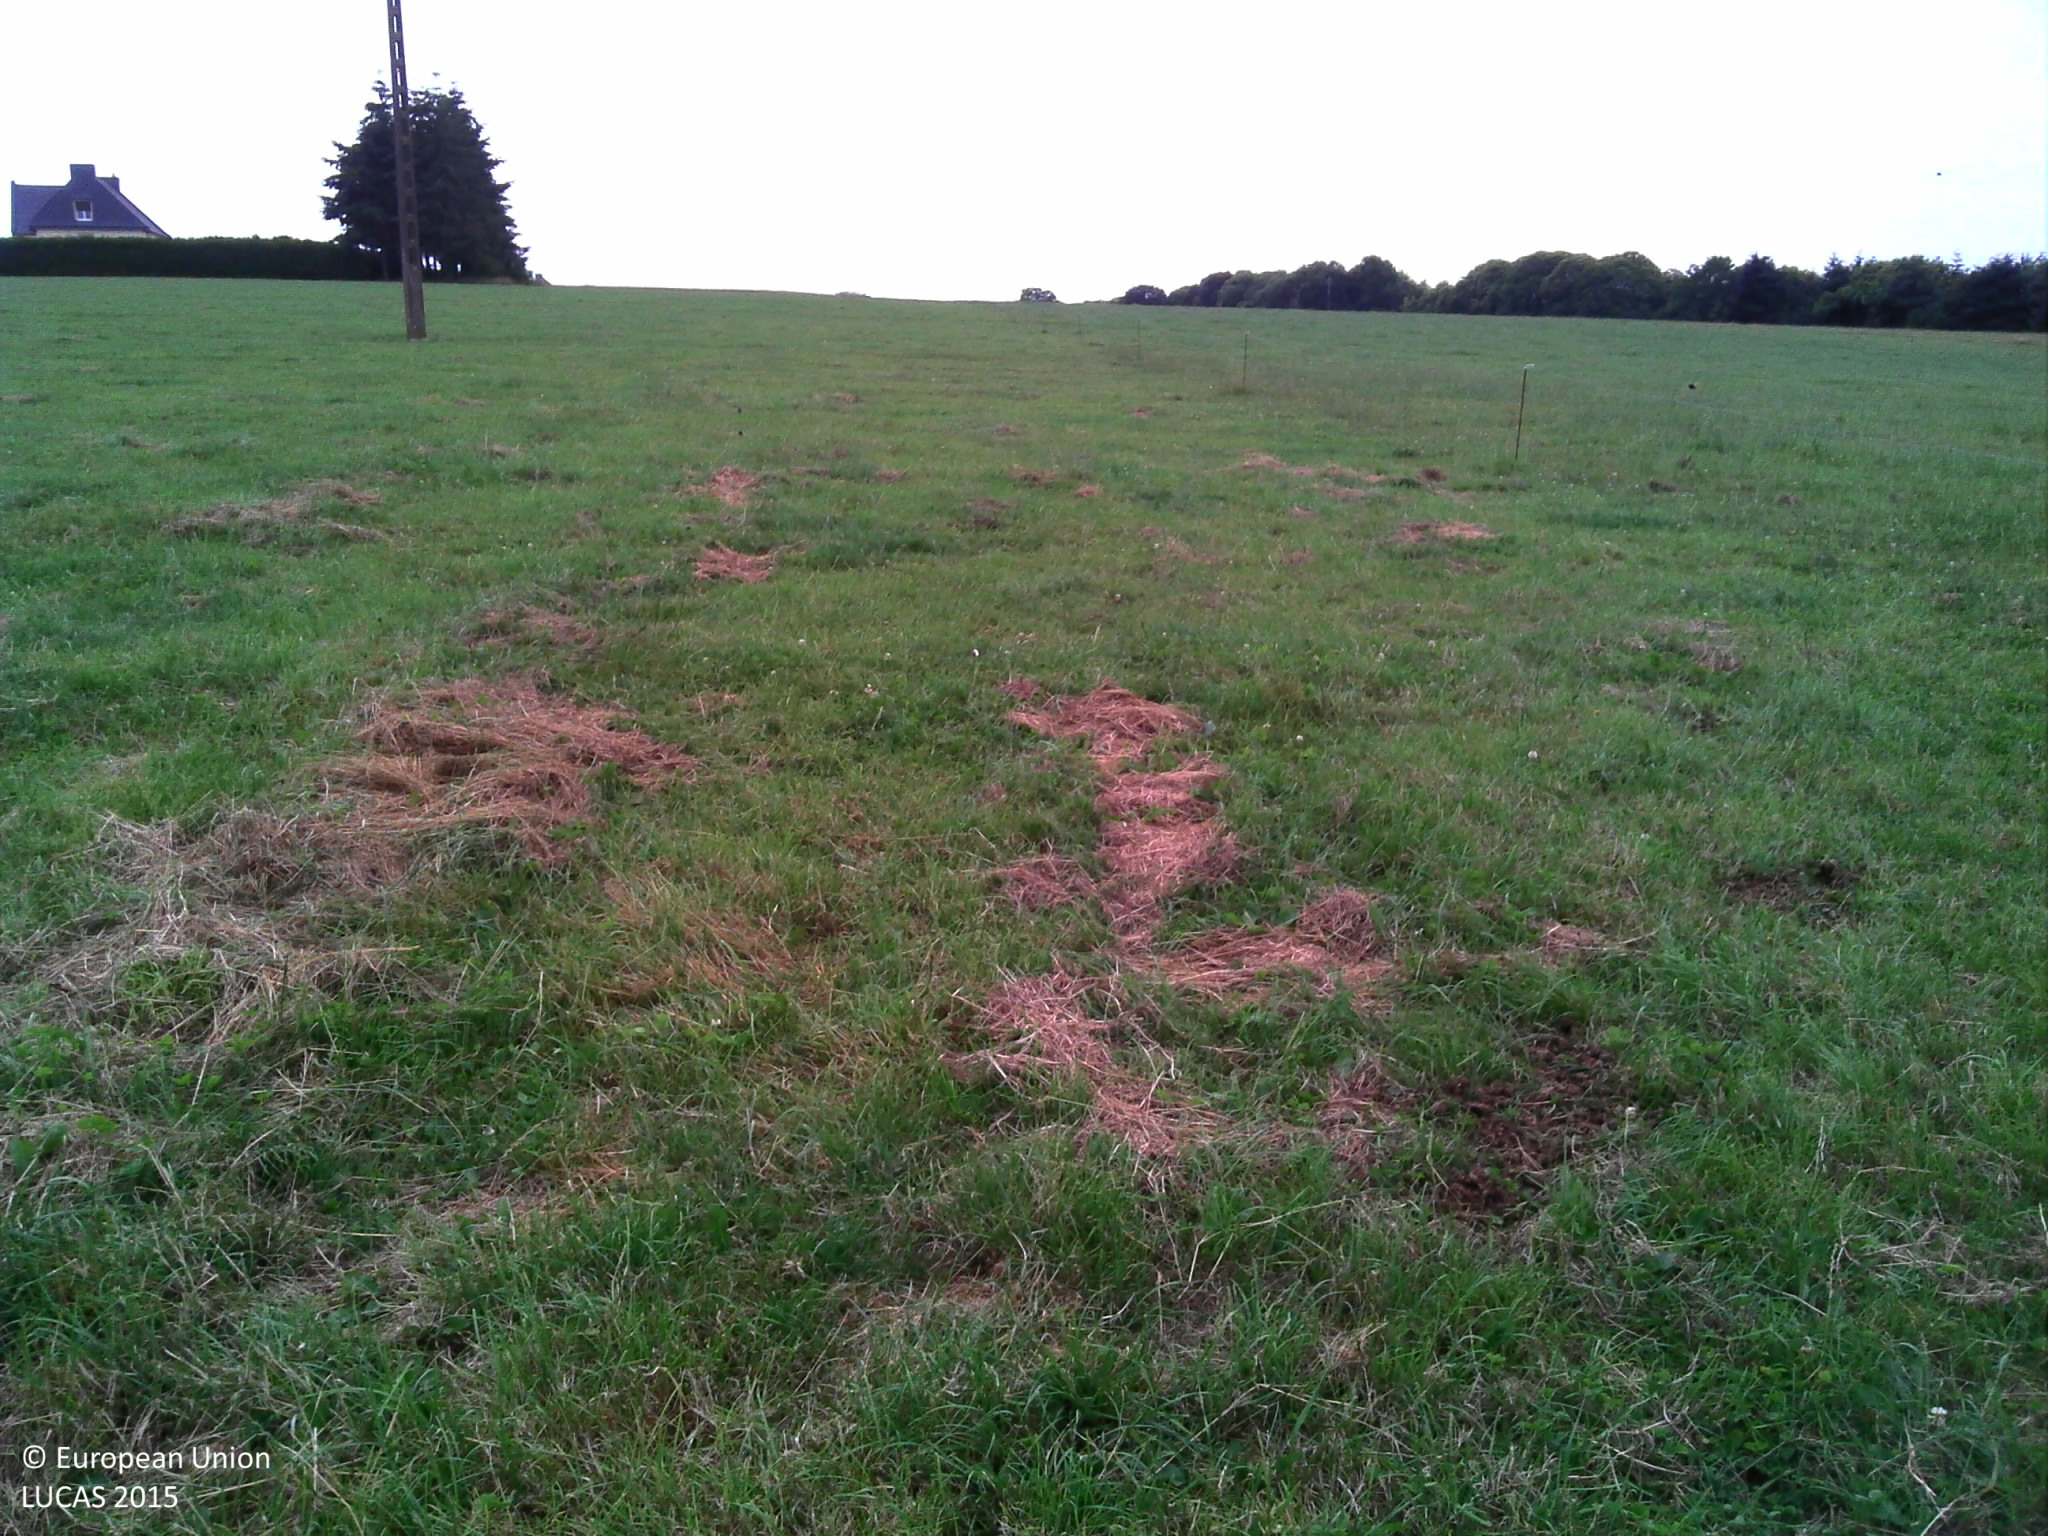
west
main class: Grassland
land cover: Grassland without tree/shrub cover
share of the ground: > 75 %
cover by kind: herbaceous plants 75 %, unconsolidated bare surface 25 %
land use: Agriculture (excluding fallow land and kitchen gardens)
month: July
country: FR
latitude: 48.5223
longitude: -2.0647
